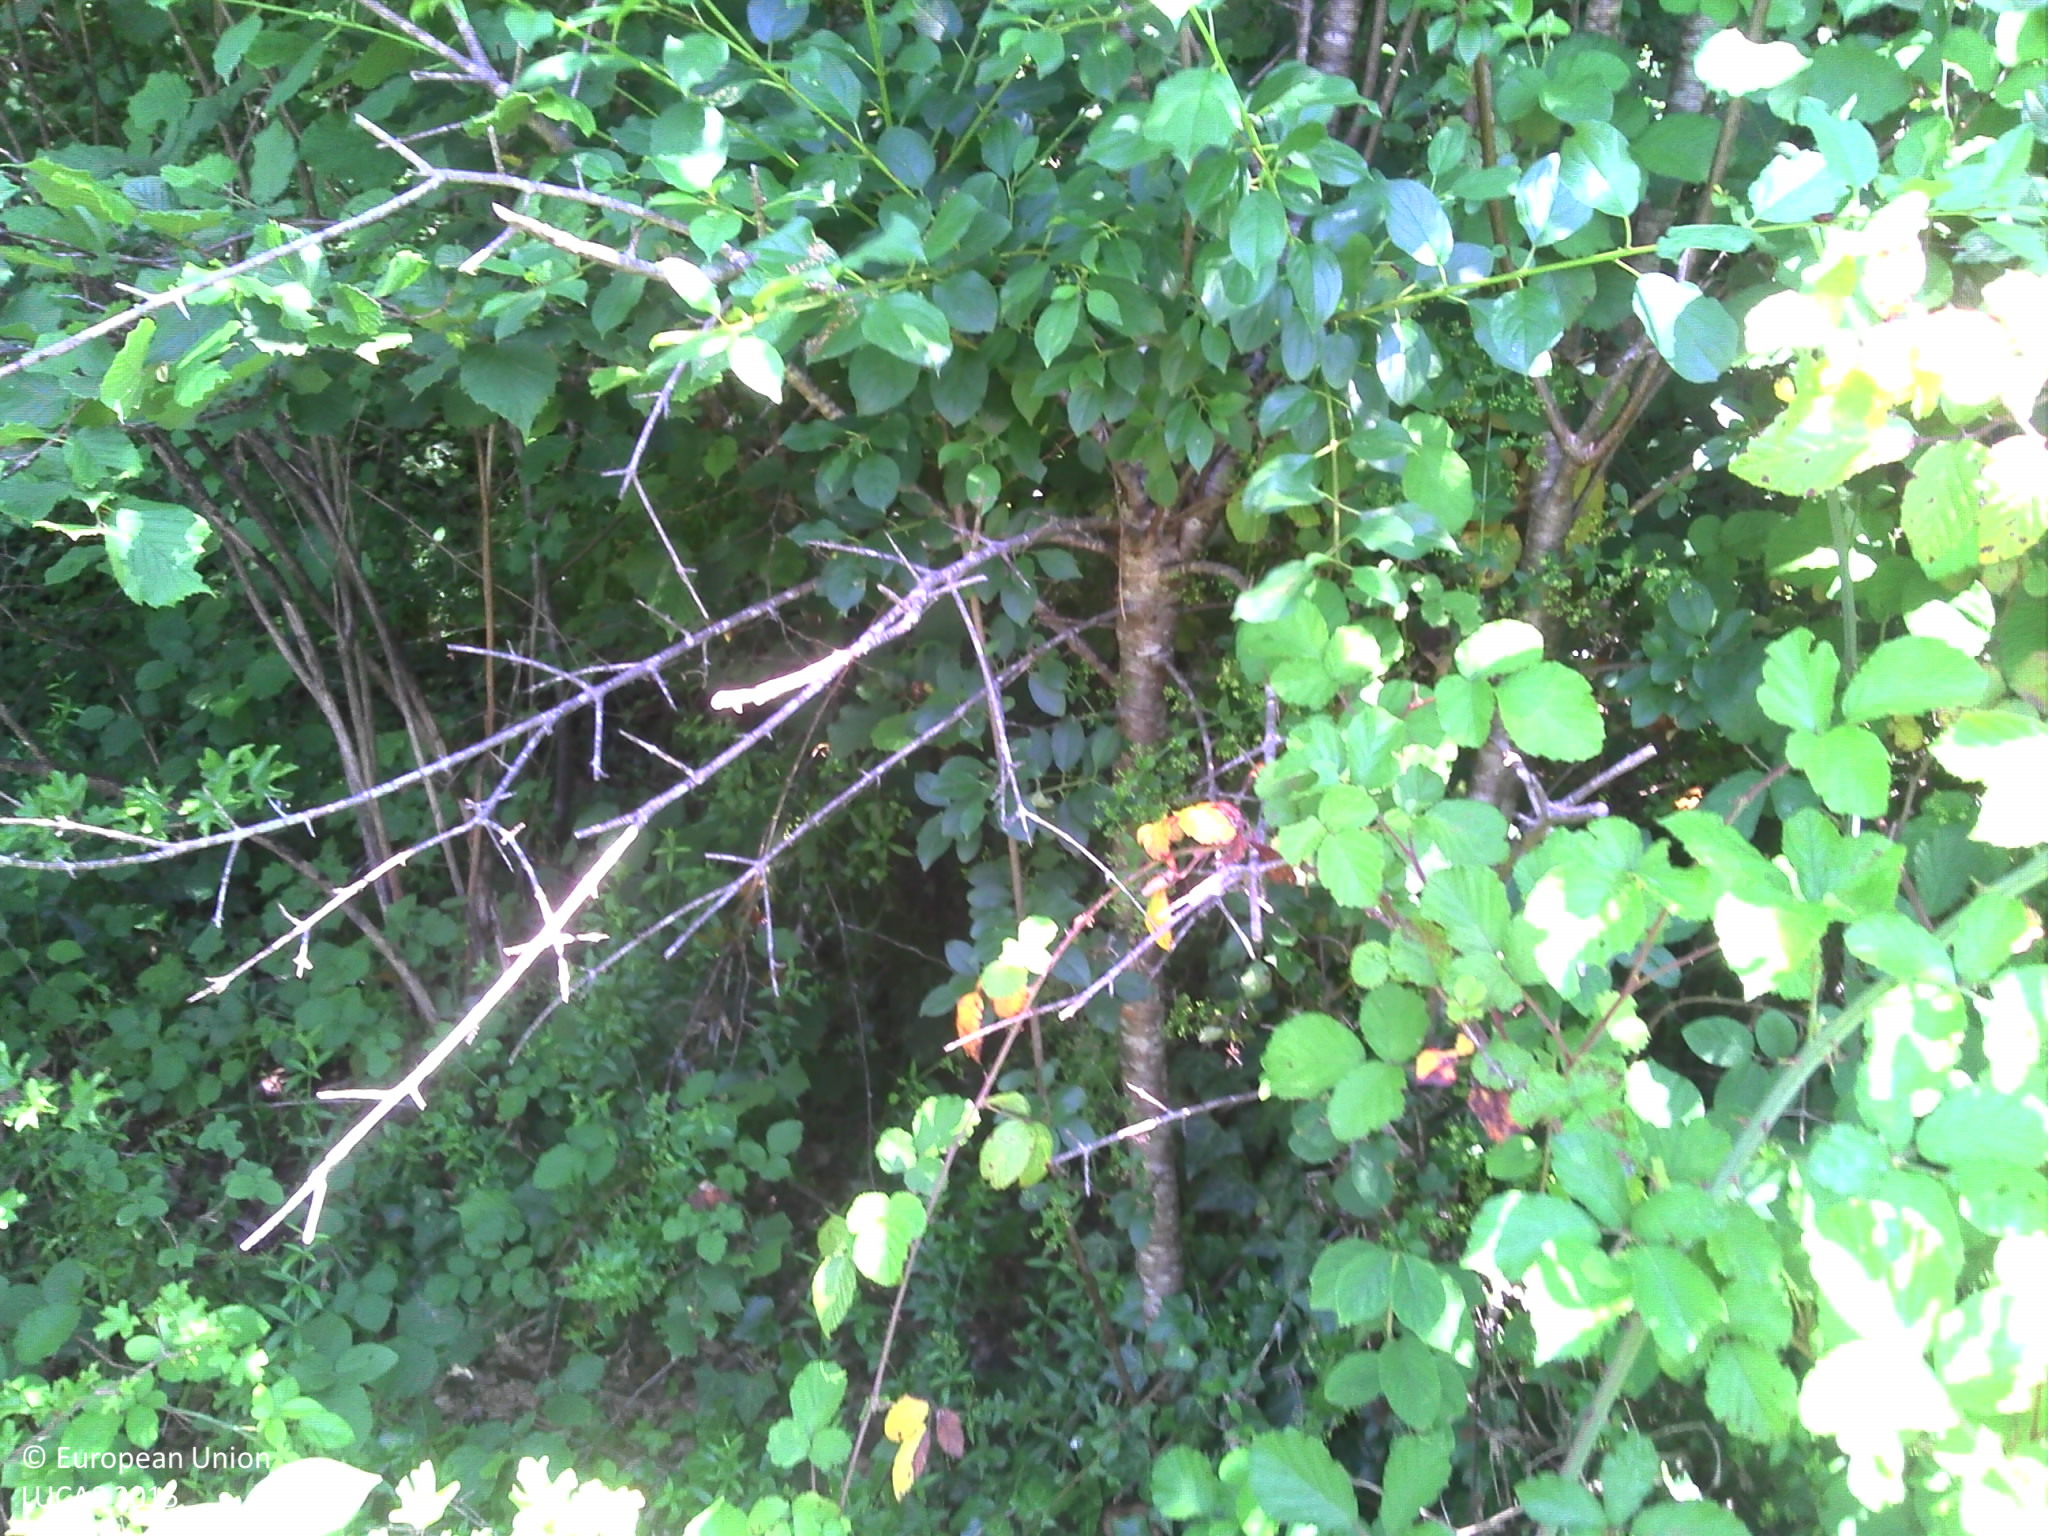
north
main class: Woodland
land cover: Broadleaved woodland
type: mesophytic deciduous forest
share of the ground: > 75 %
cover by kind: broadleaved forest trees 85 %, herbaceous plants 15 %
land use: Forestry
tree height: > 5 m
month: June
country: FR
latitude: 46.4776
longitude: 4.8049
